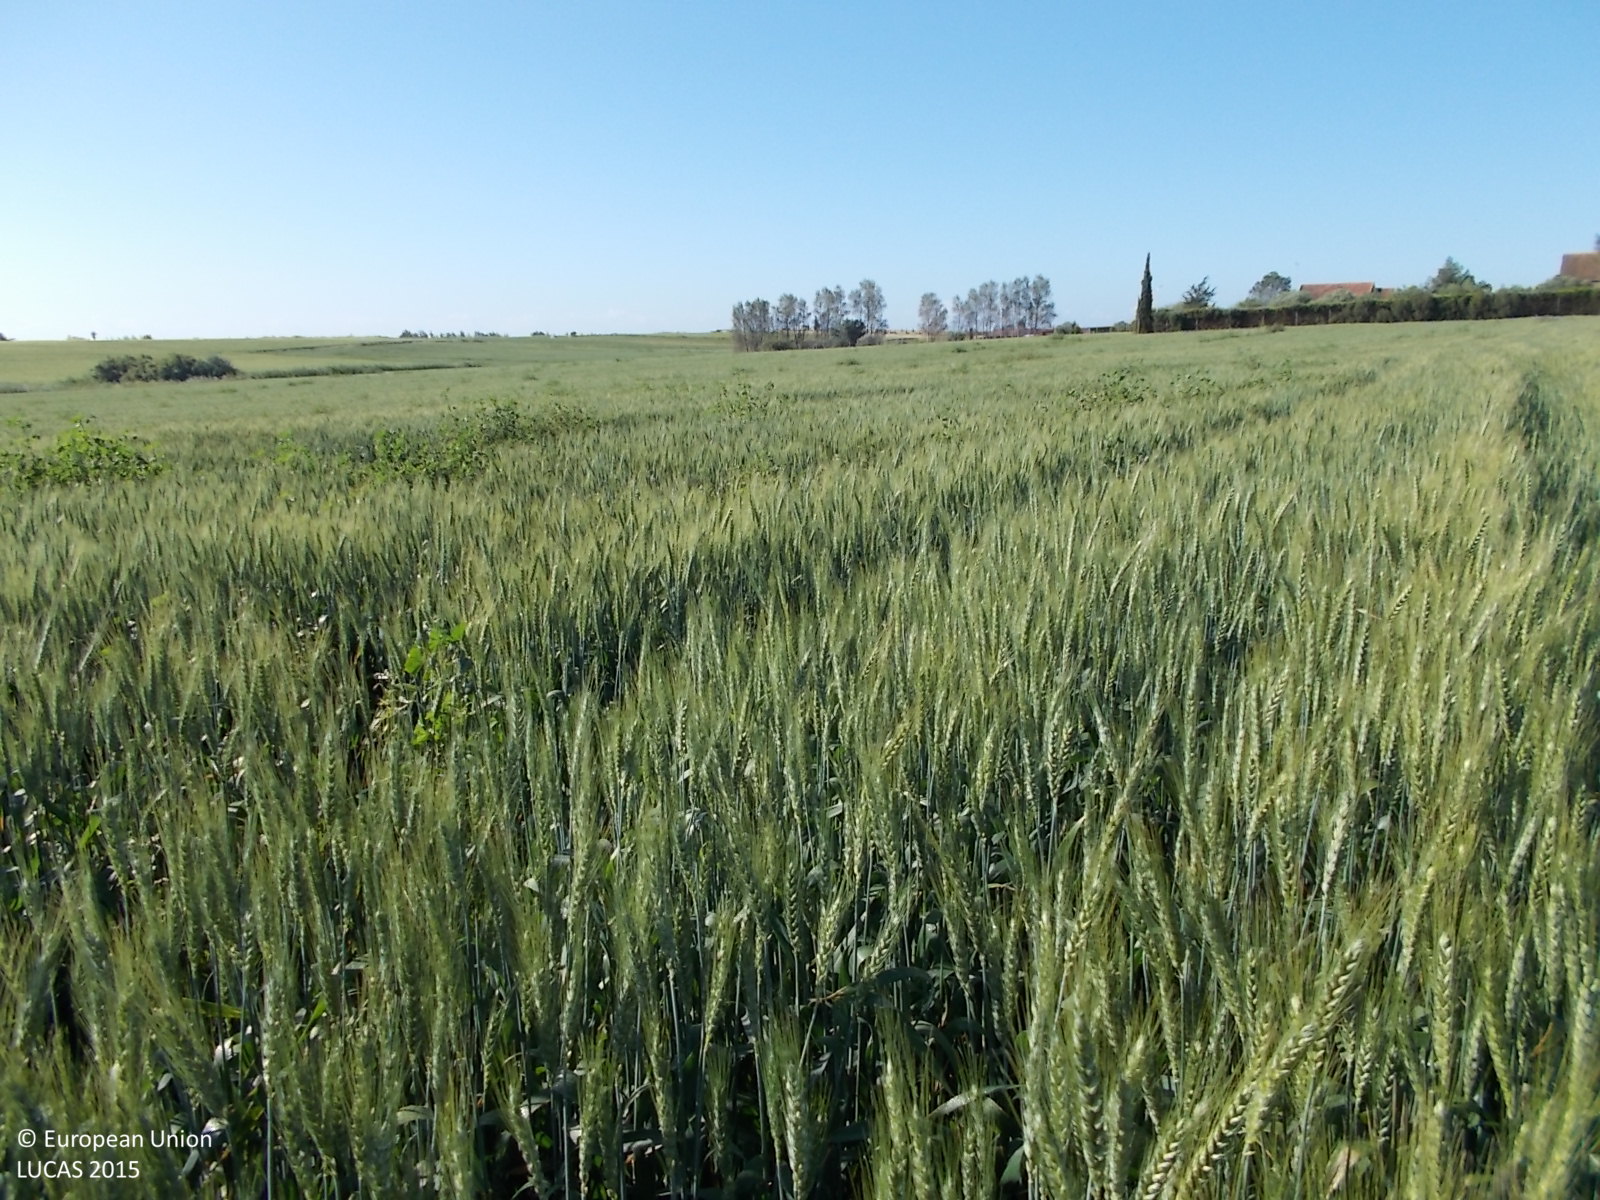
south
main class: Cropland
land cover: Common wheat
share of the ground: > 75 %
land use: Agriculture (excluding fallow land and kitchen gardens)
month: April
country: CY
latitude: 34.8887
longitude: 33.5762
